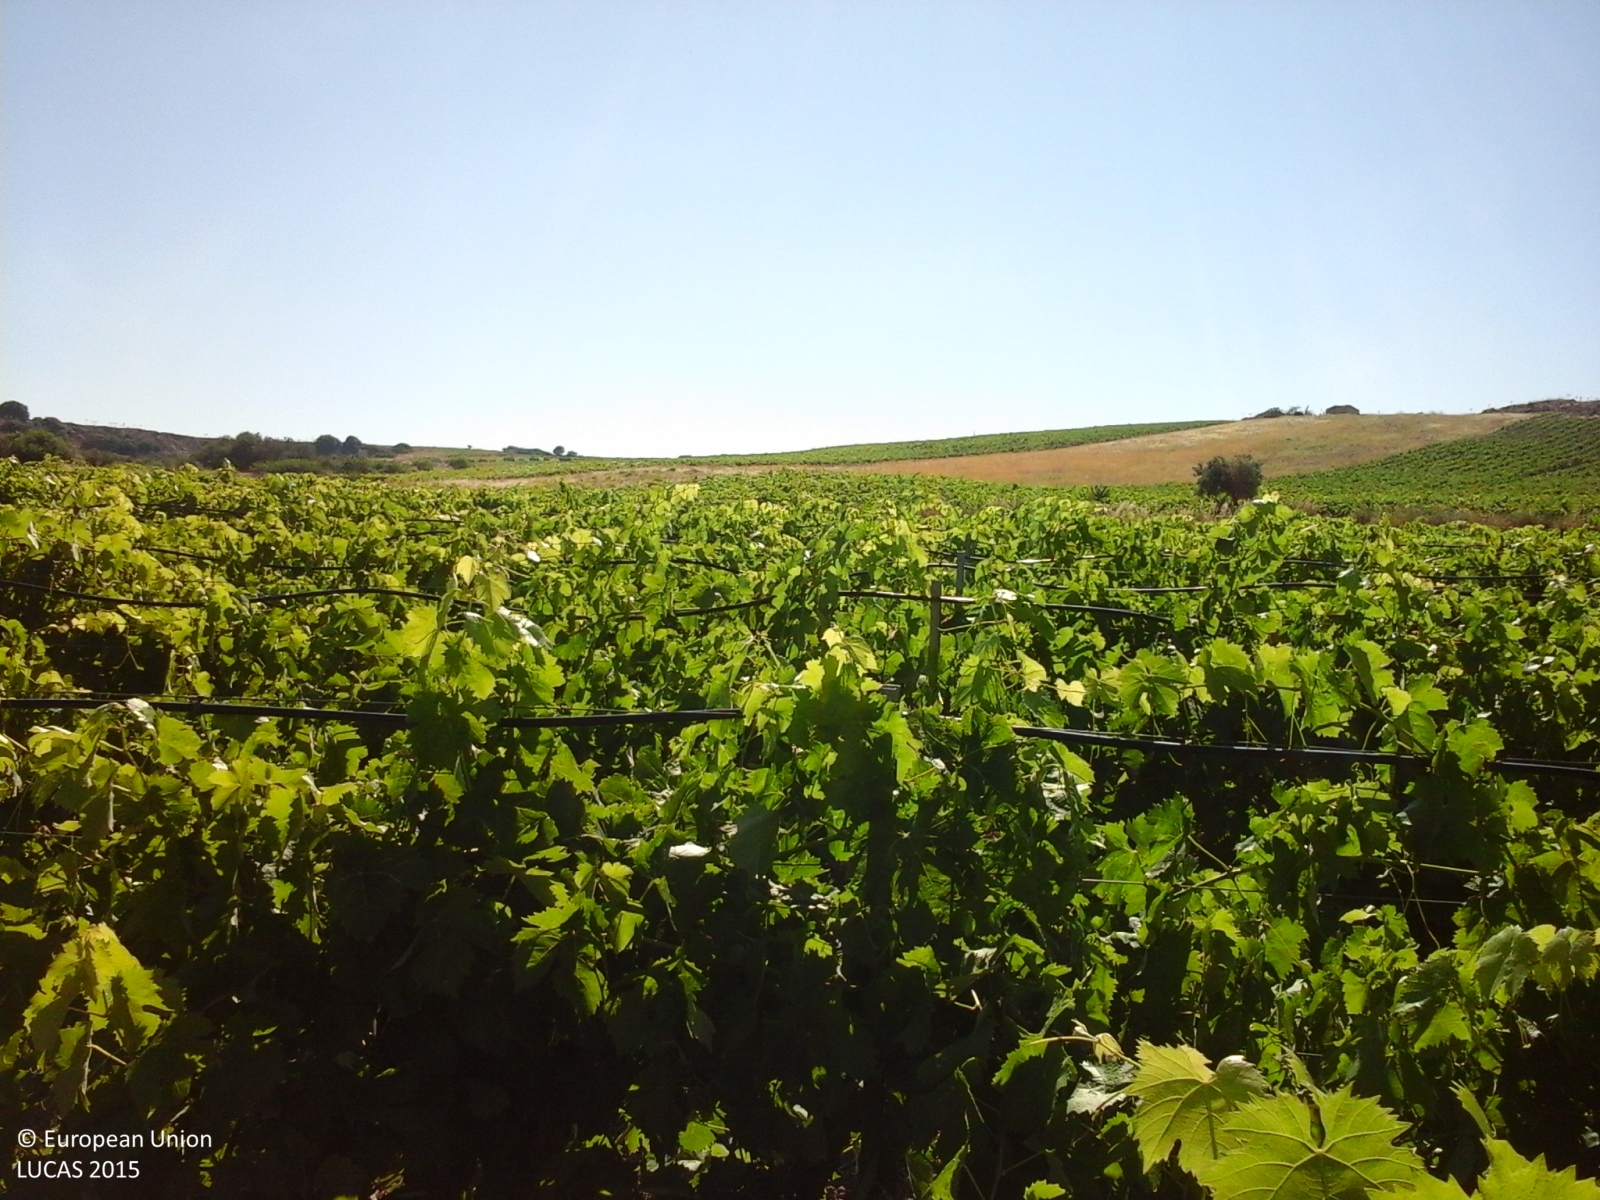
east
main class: Cropland
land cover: Vineyards
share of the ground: 50 - 75 %
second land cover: Other bare soil
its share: > 75 %
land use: Agriculture (excluding fallow land and kitchen gardens)
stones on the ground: < 10 %
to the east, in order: Vineyards; Other bare soil; Grass margins; Vineyards; Spontaneously vegetated surfaces
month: June
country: IT
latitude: 37.7101
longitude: 12.6683
